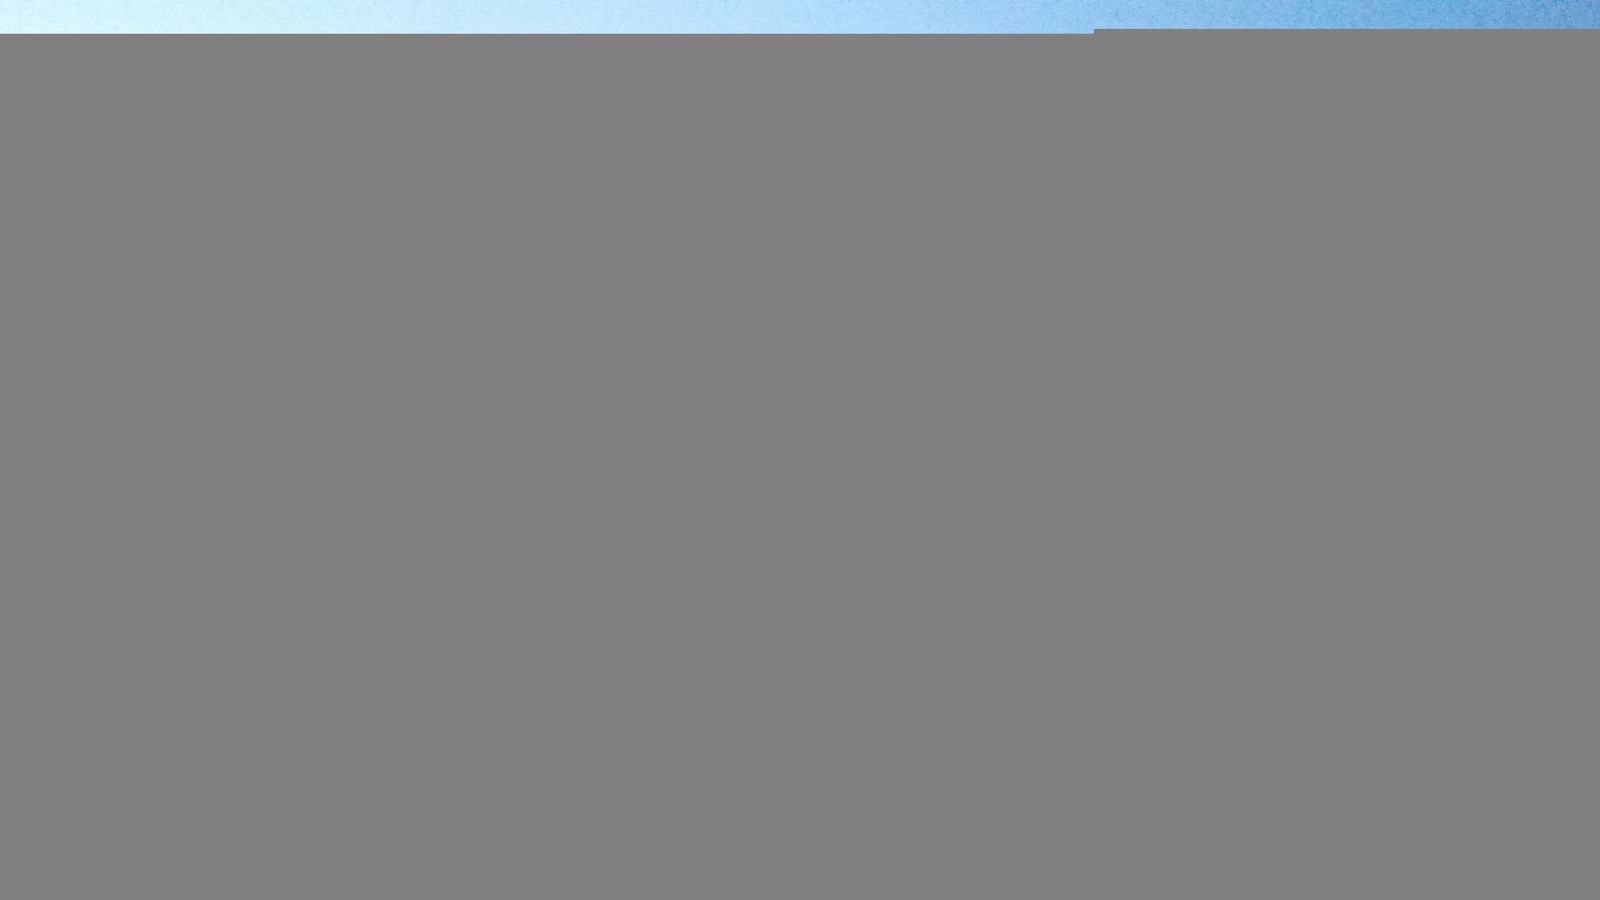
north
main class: Grassland
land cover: Grassland without tree/shrub cover
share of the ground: > 75 %
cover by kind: herbaceous plants 100 %
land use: Agriculture (excluding fallow land and kitchen gardens)
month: September
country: RO
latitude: 47.9366
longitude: 23.6391
